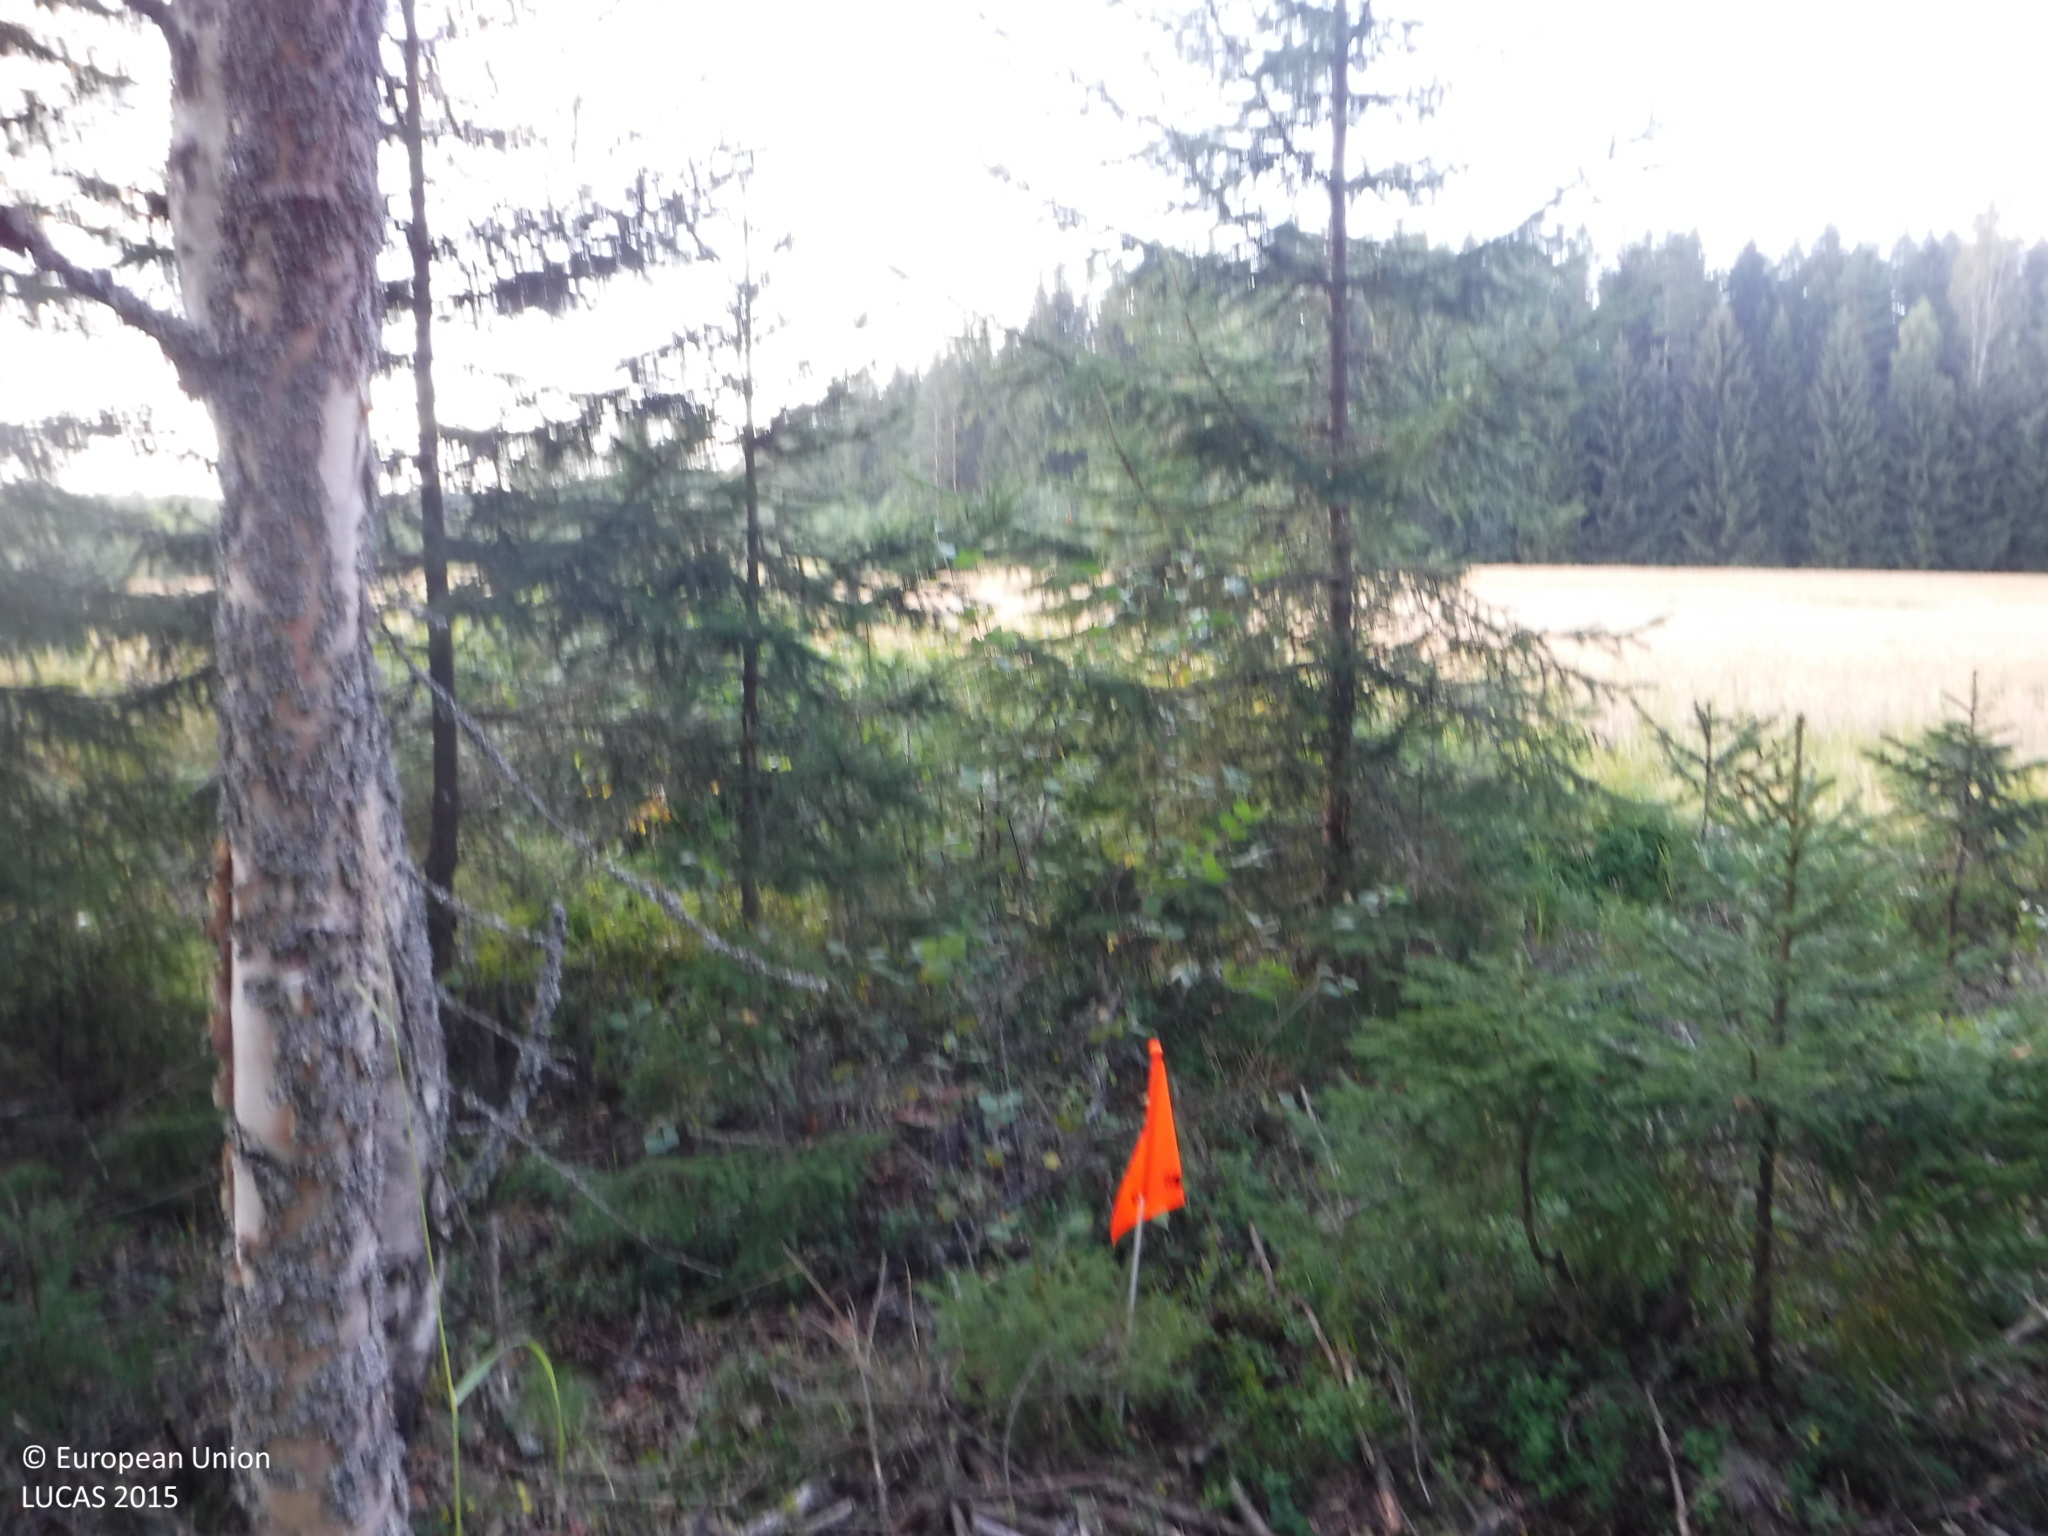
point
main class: Woodland
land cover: Spruce dominated mixed woodland
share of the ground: 50 - 75 %
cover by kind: coniferous forest trees 40 %, broadleaved forest trees 30 %, shrubs 10 %, lichens and mosses 10 %
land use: Forestry
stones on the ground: < 10 %
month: August
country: FI
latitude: 61.1820
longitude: 23.0362
